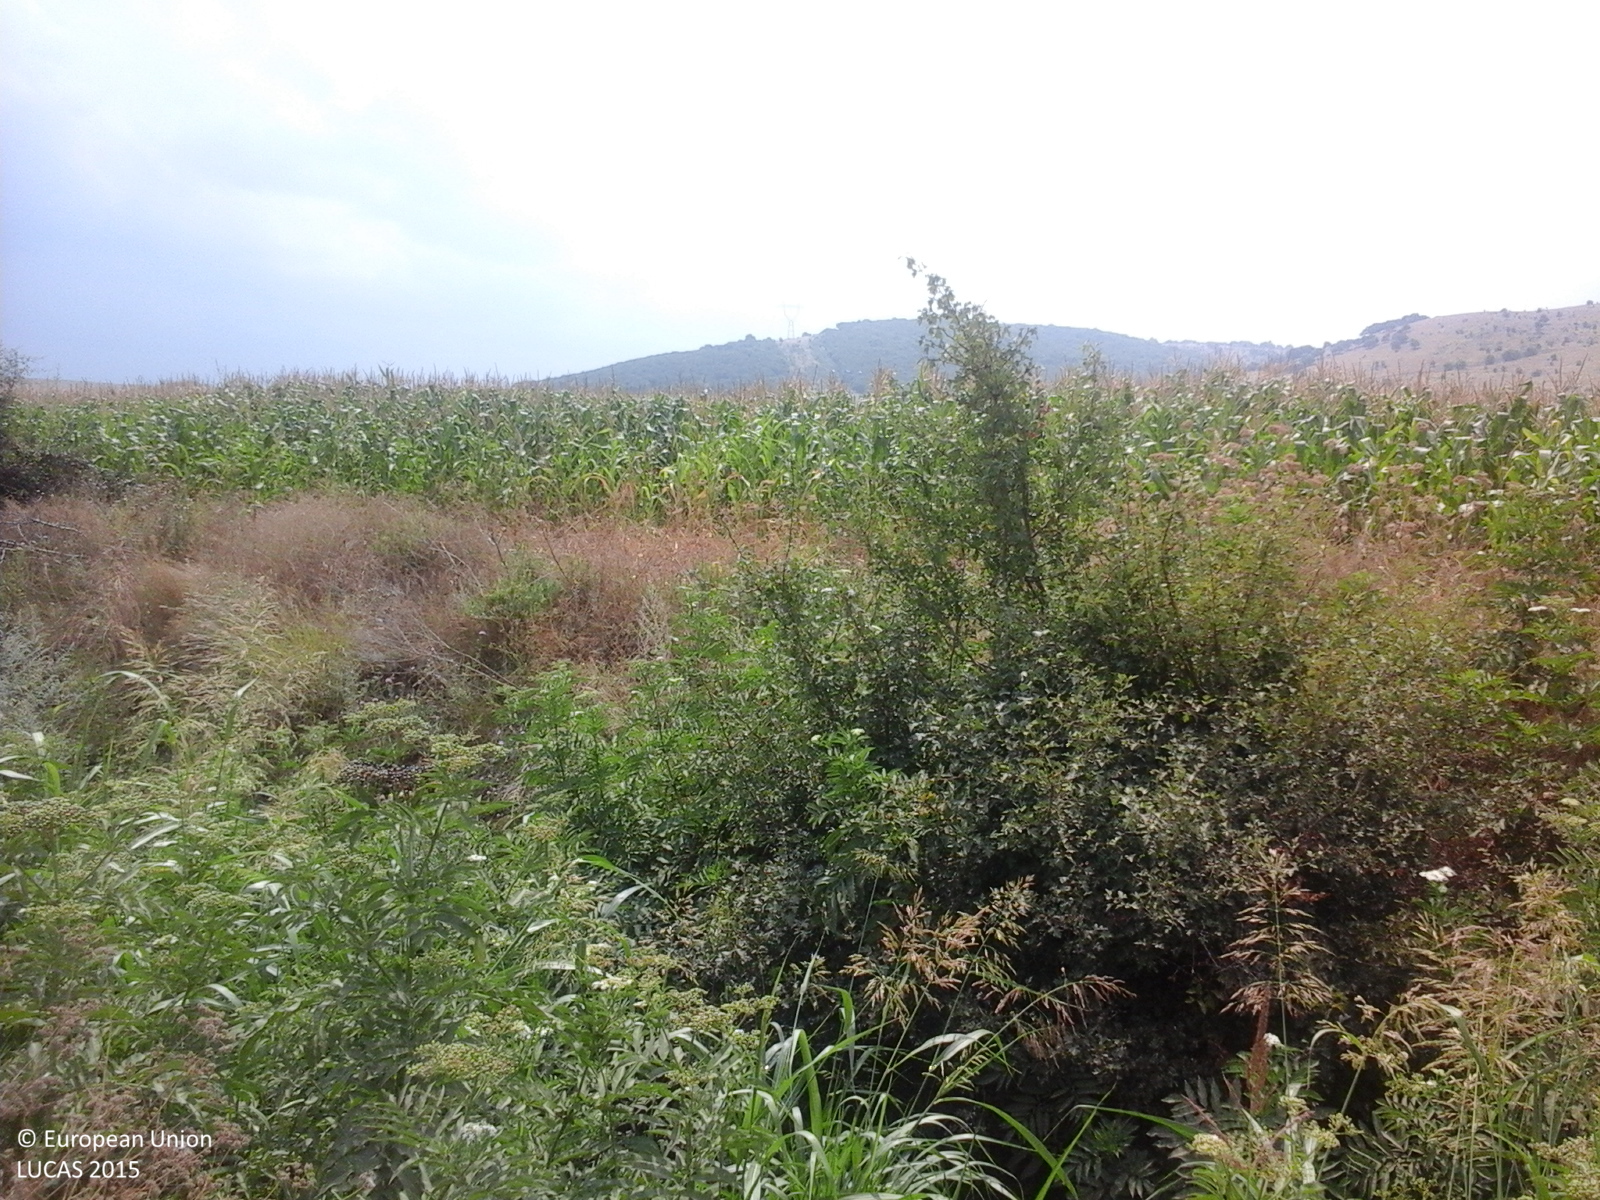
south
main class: Cropland
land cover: Maize
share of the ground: > 75 %
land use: Agriculture (excluding fallow land and kitchen gardens)
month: July
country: RO
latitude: 44.9546
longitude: 28.6267
